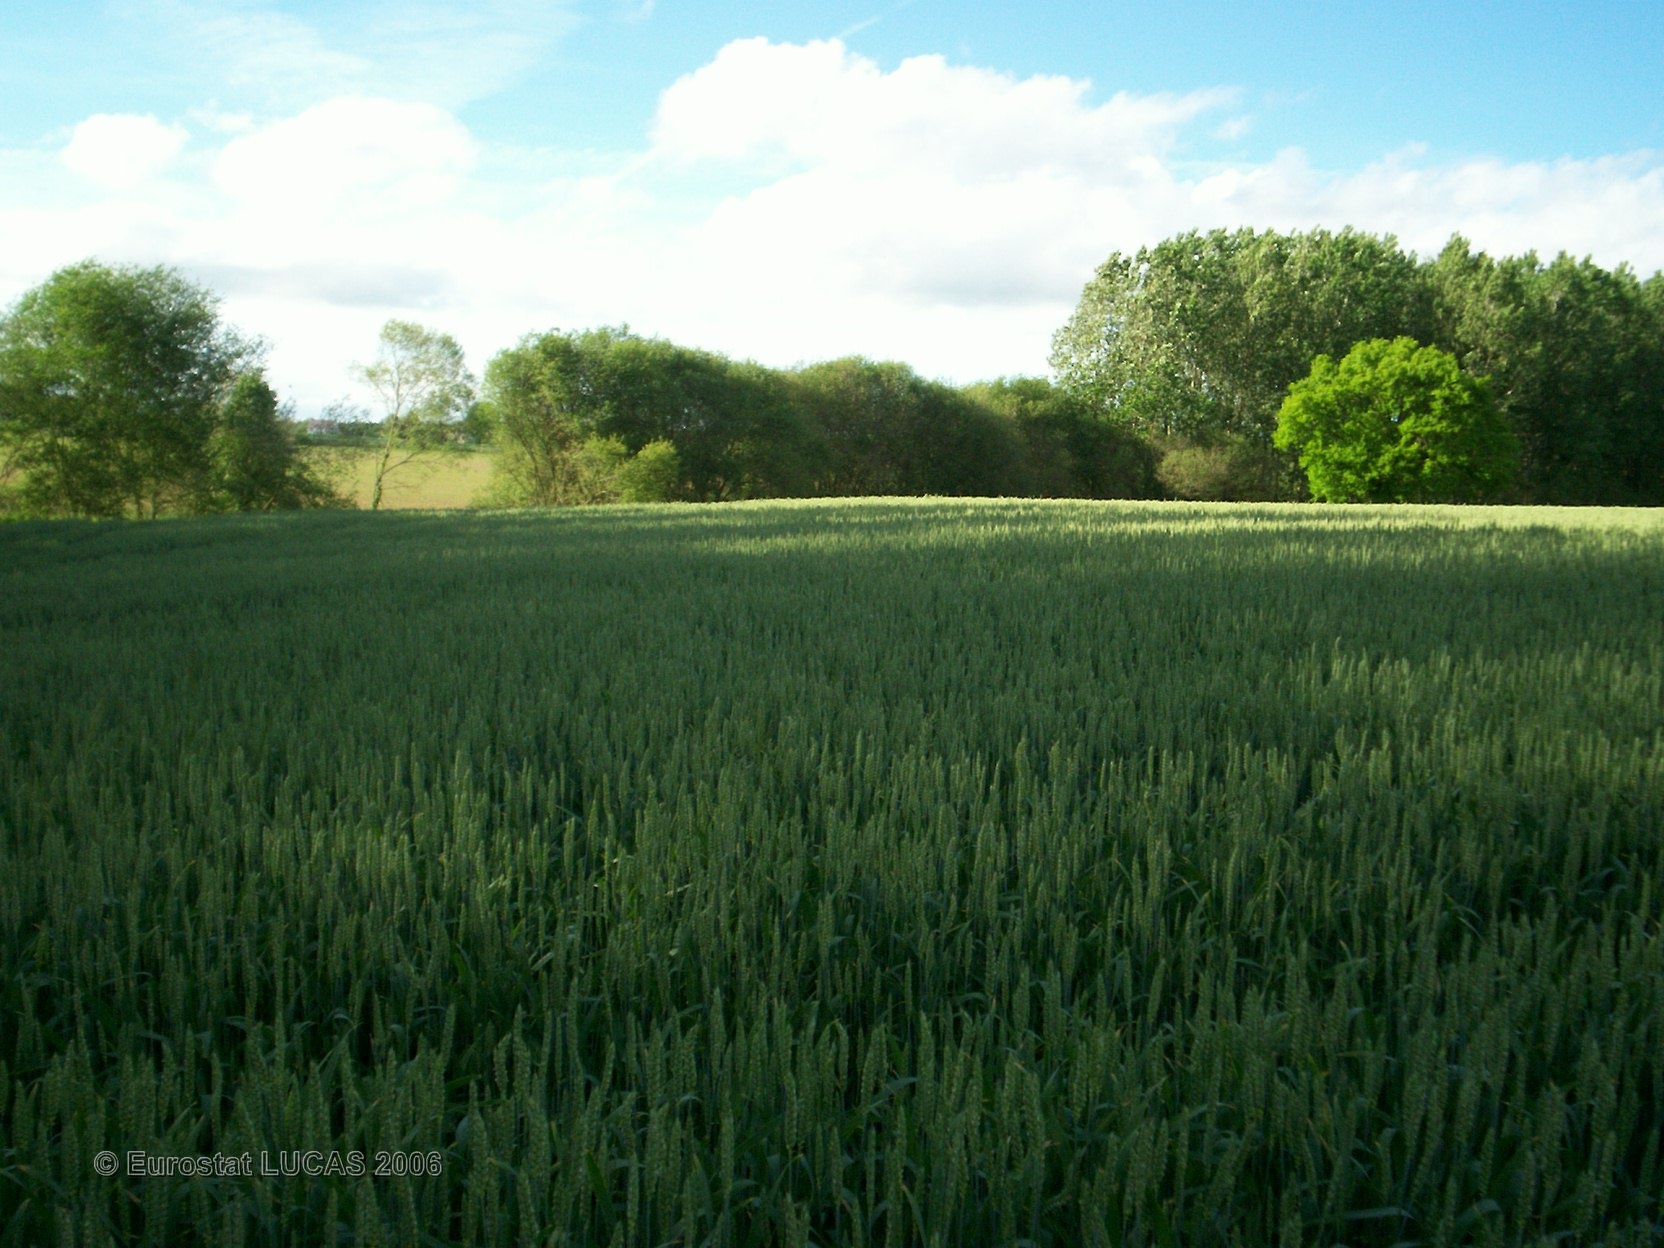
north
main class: Cropland
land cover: Common wheat
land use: Agriculture (excluding fallow land and kitchen gardens)
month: May
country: FR
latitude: 48.4482
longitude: -2.4037
